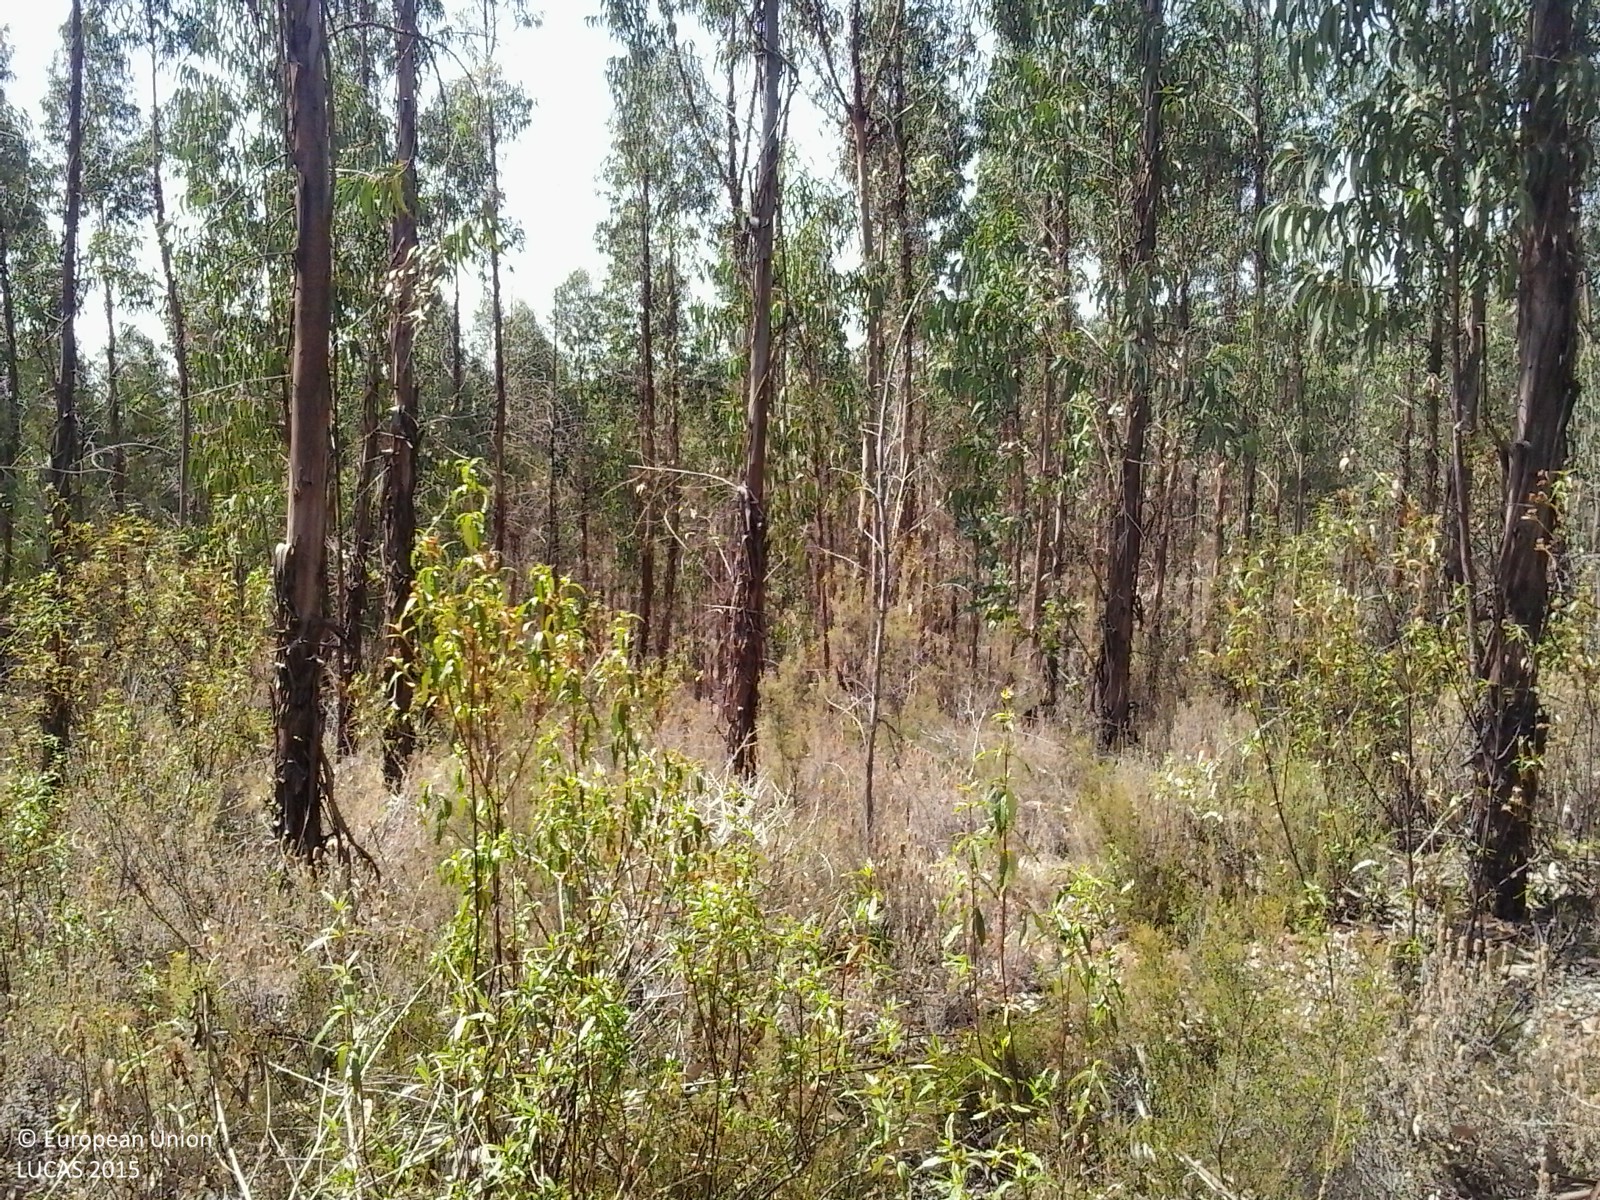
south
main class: Woodland
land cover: Broadleaved woodland
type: exotic forest
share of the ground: 25 - 50 %
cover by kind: broadleaved forest trees 45 %, shrubs 25 %, herbaceous plants 25 %, unconsolidated bare surface 5 %
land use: Forestry
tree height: > 5 m
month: July
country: ES
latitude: 37.5219
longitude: -6.4520
